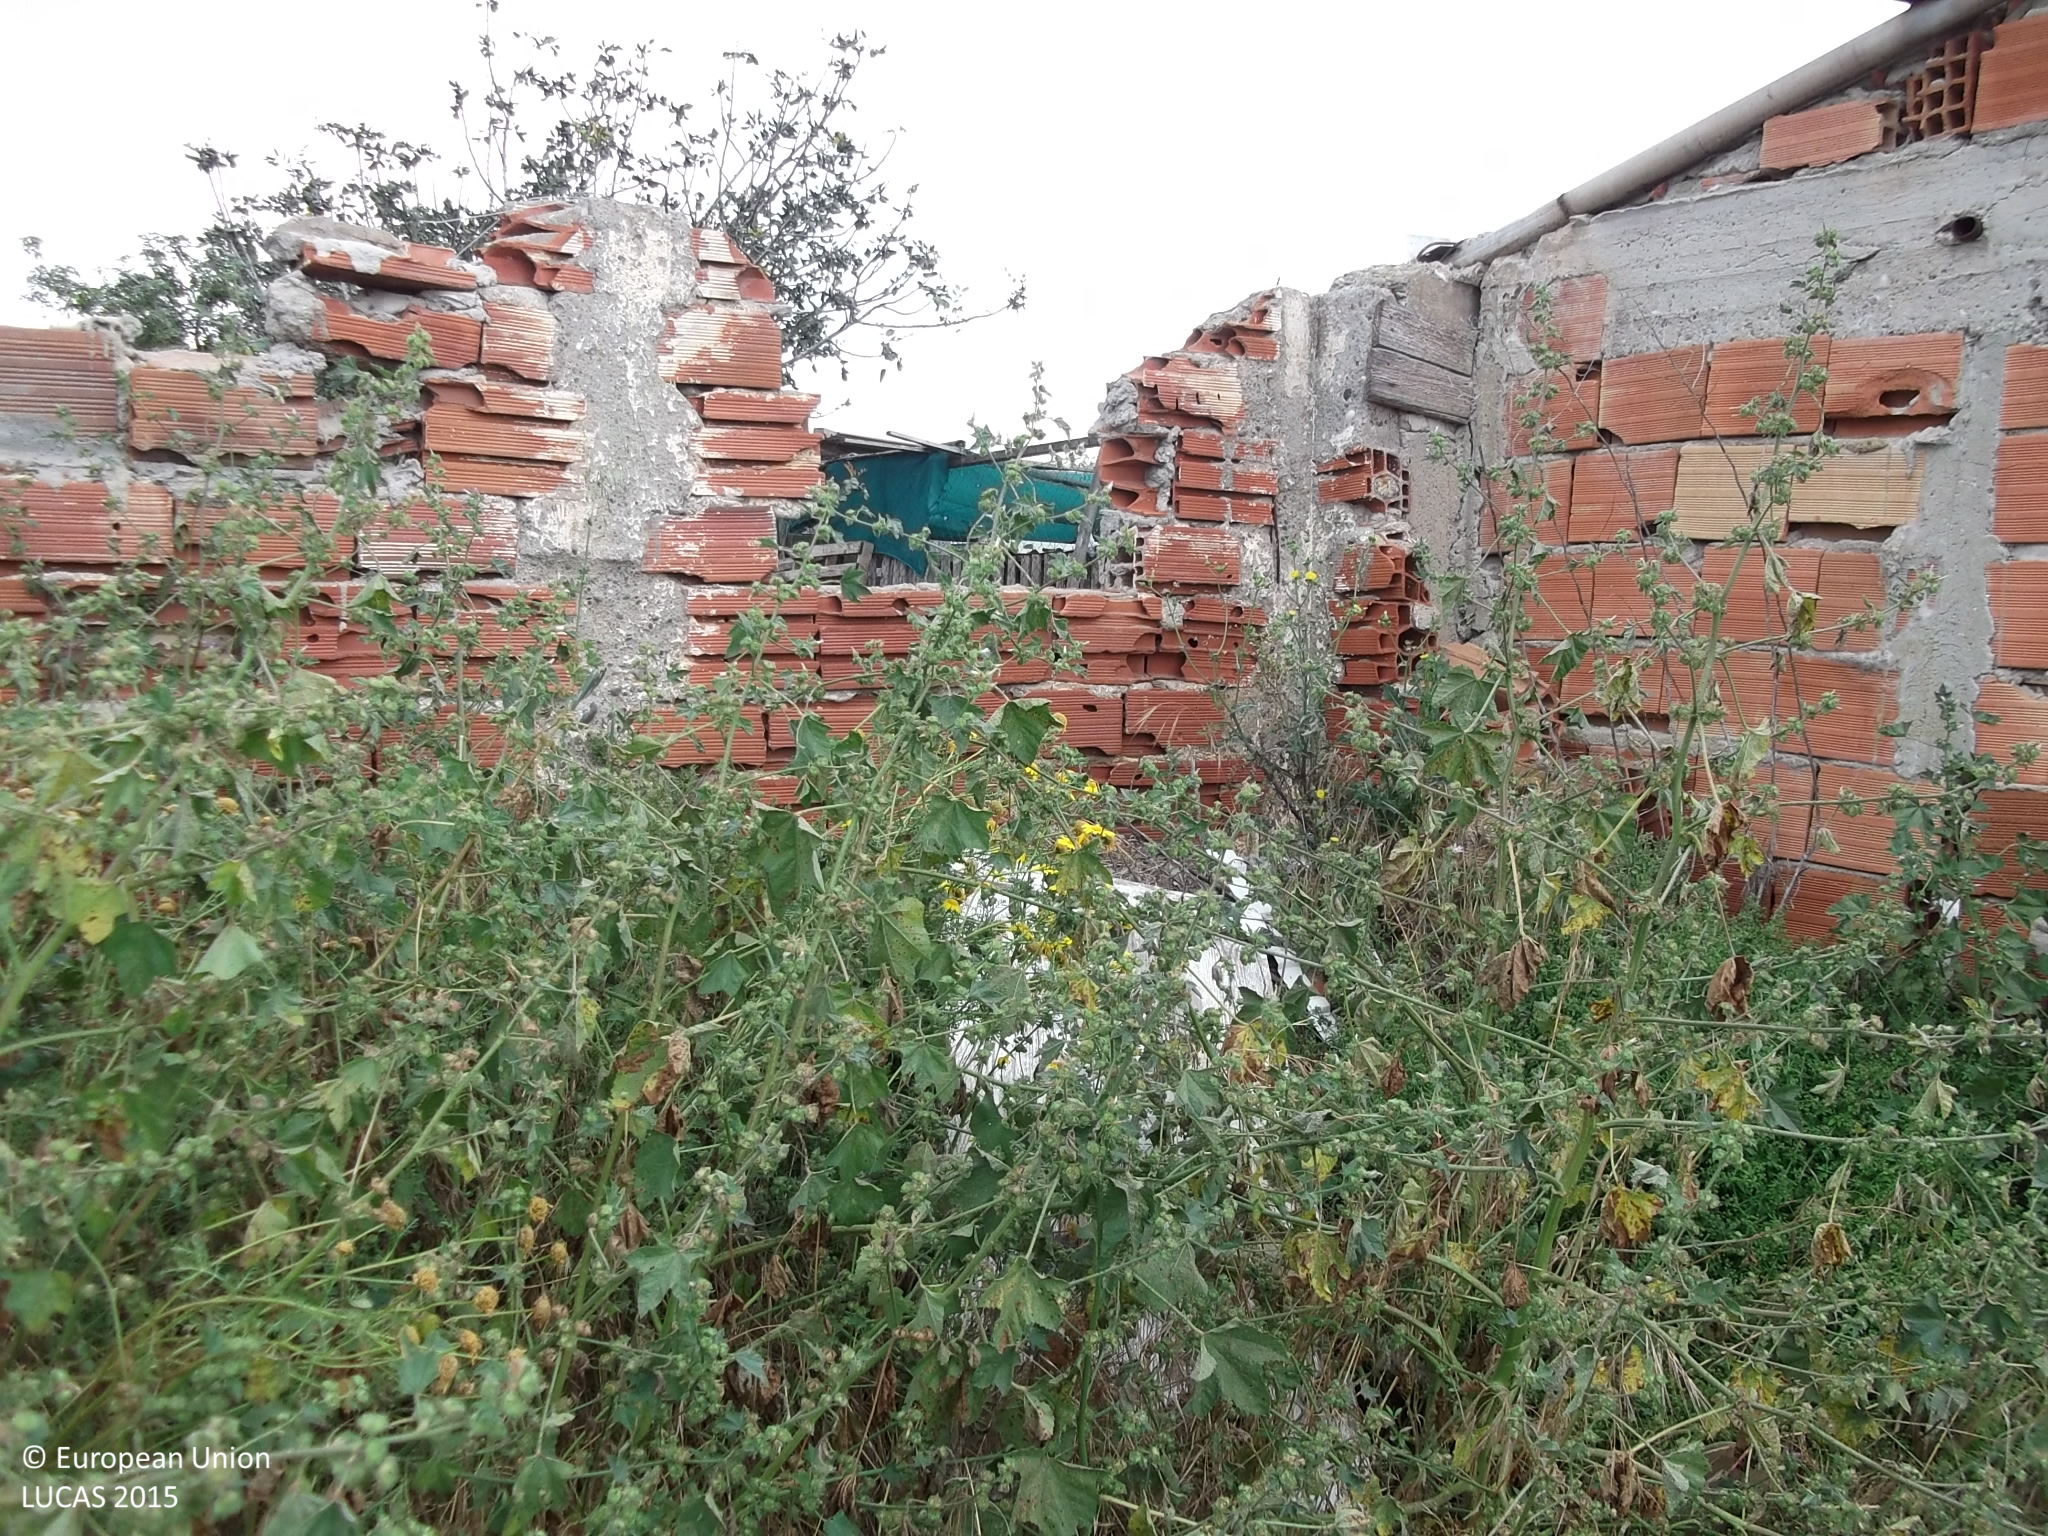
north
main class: Grassland
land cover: Grassland without tree/shrub cover
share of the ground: > 75 %
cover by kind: herbaceous plants 100 %
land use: Abandoned areas
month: April
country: CY
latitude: 34.7960
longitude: 33.5000
